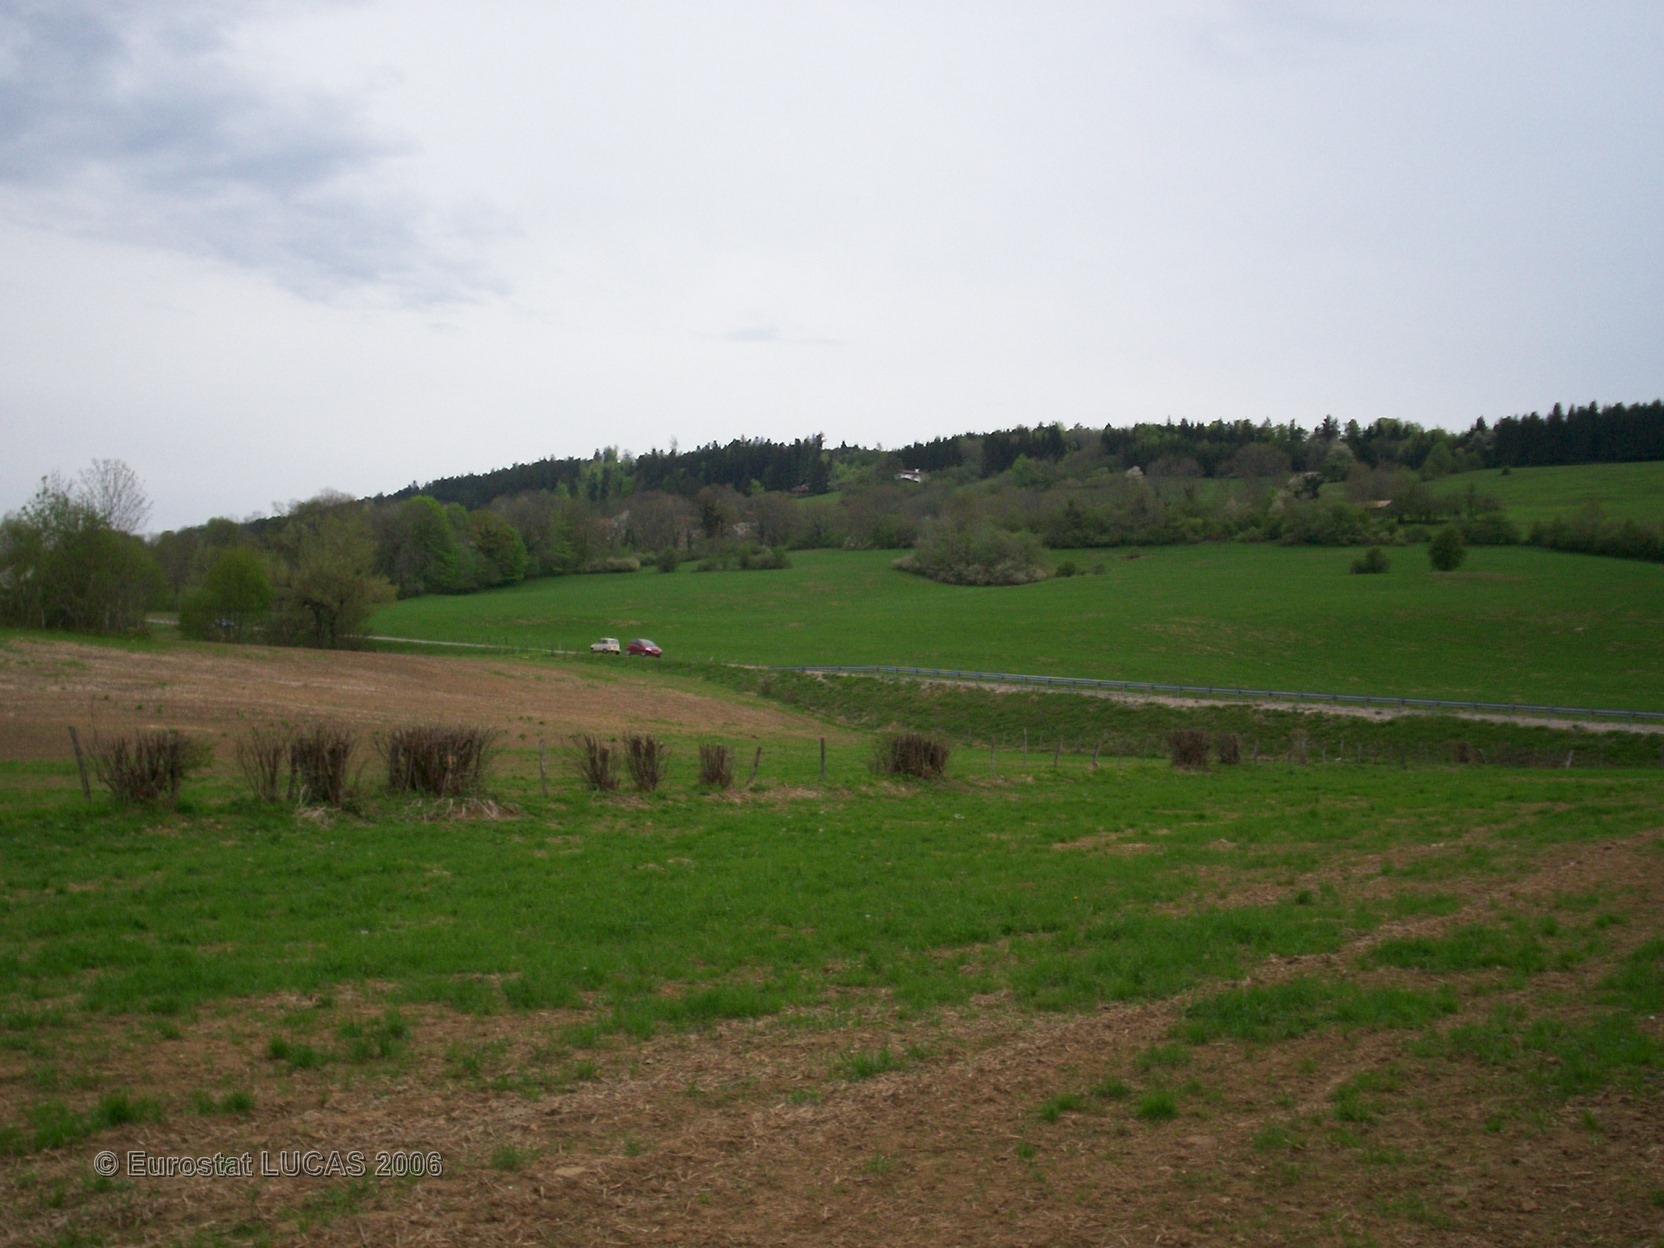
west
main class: Grassland
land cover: Grassland without tree/shrub cover
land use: Agriculture (excluding fallow land and kitchen gardens)
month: May
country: FR
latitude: 47.2598
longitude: 6.8436
